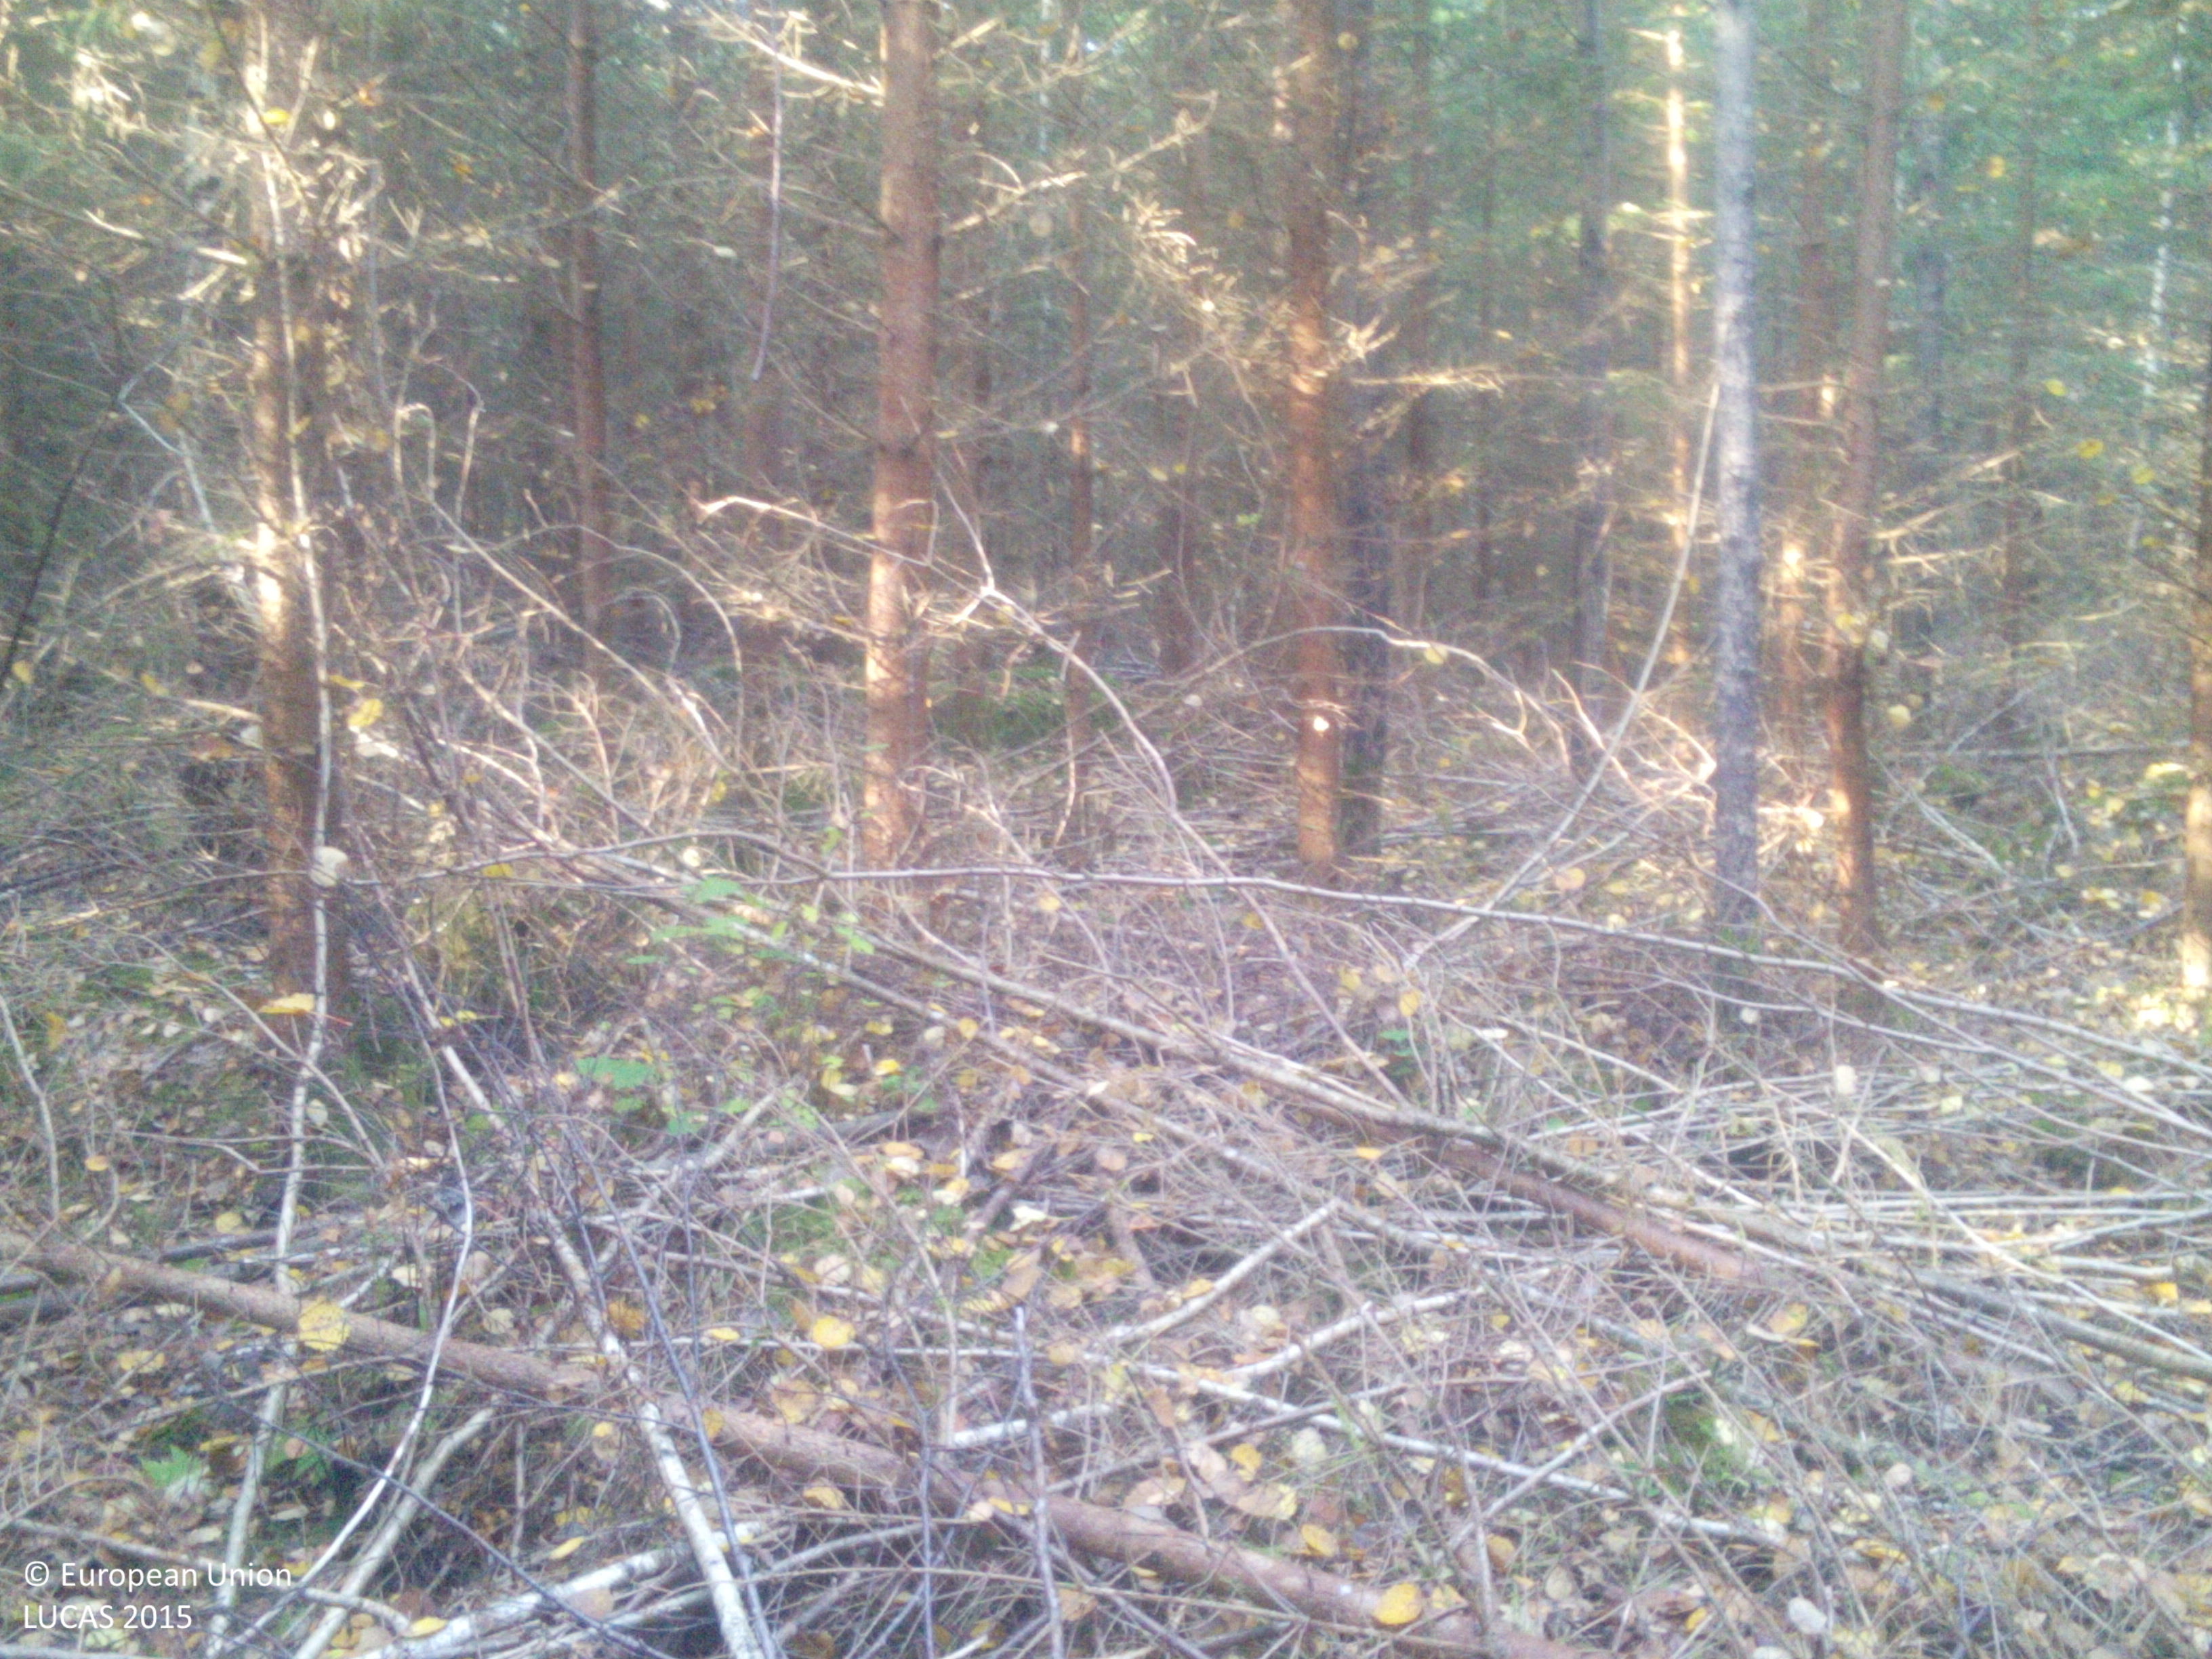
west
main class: Woodland
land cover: Spruce dominated mixed woodland
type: boreal forest
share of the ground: > 75 %
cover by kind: coniferous forest trees 55 %, broadleaved forest trees 40 %, lichens and mosses 5 %
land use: Forestry
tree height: > 5 m
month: October
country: SE
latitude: 58.8943
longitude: 16.4678
